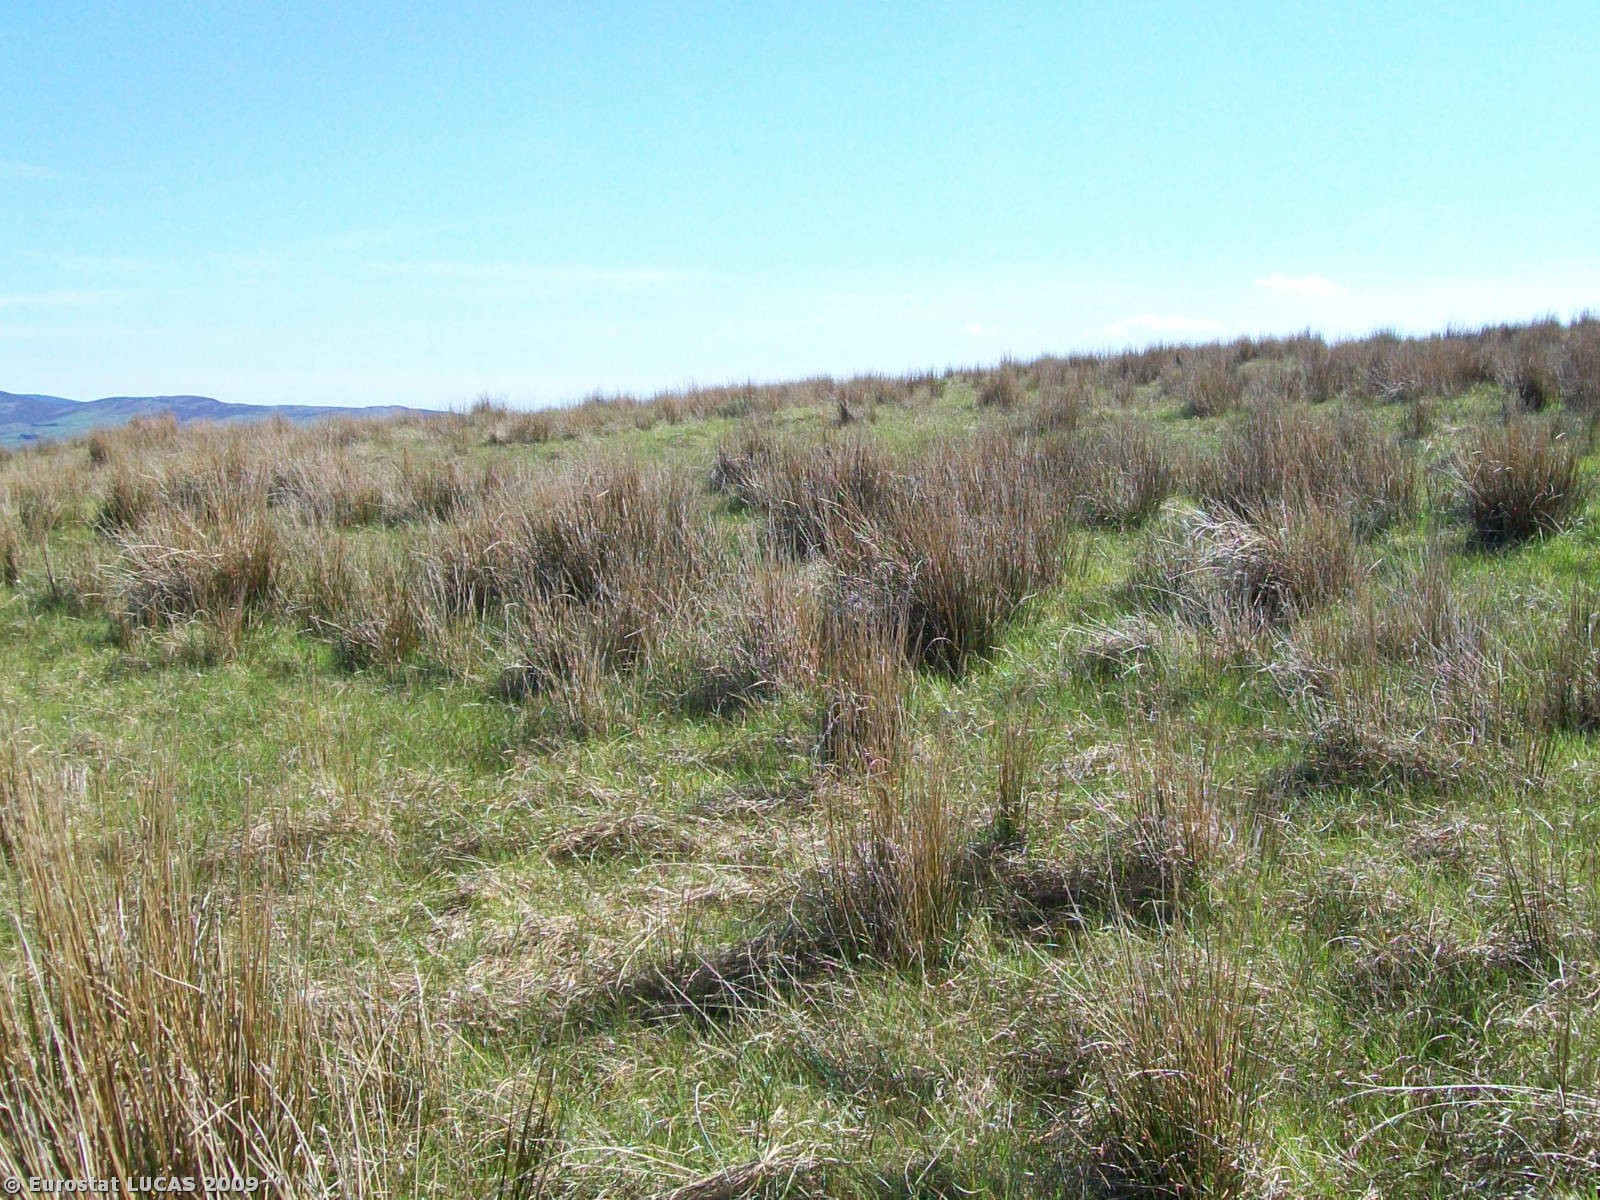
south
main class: Grassland
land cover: Grassland without tree/shrub cover
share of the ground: > 75 %
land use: Agriculture (excluding fallow land and kitchen gardens)
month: May
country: GB
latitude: 54.7736
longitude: -7.3269
